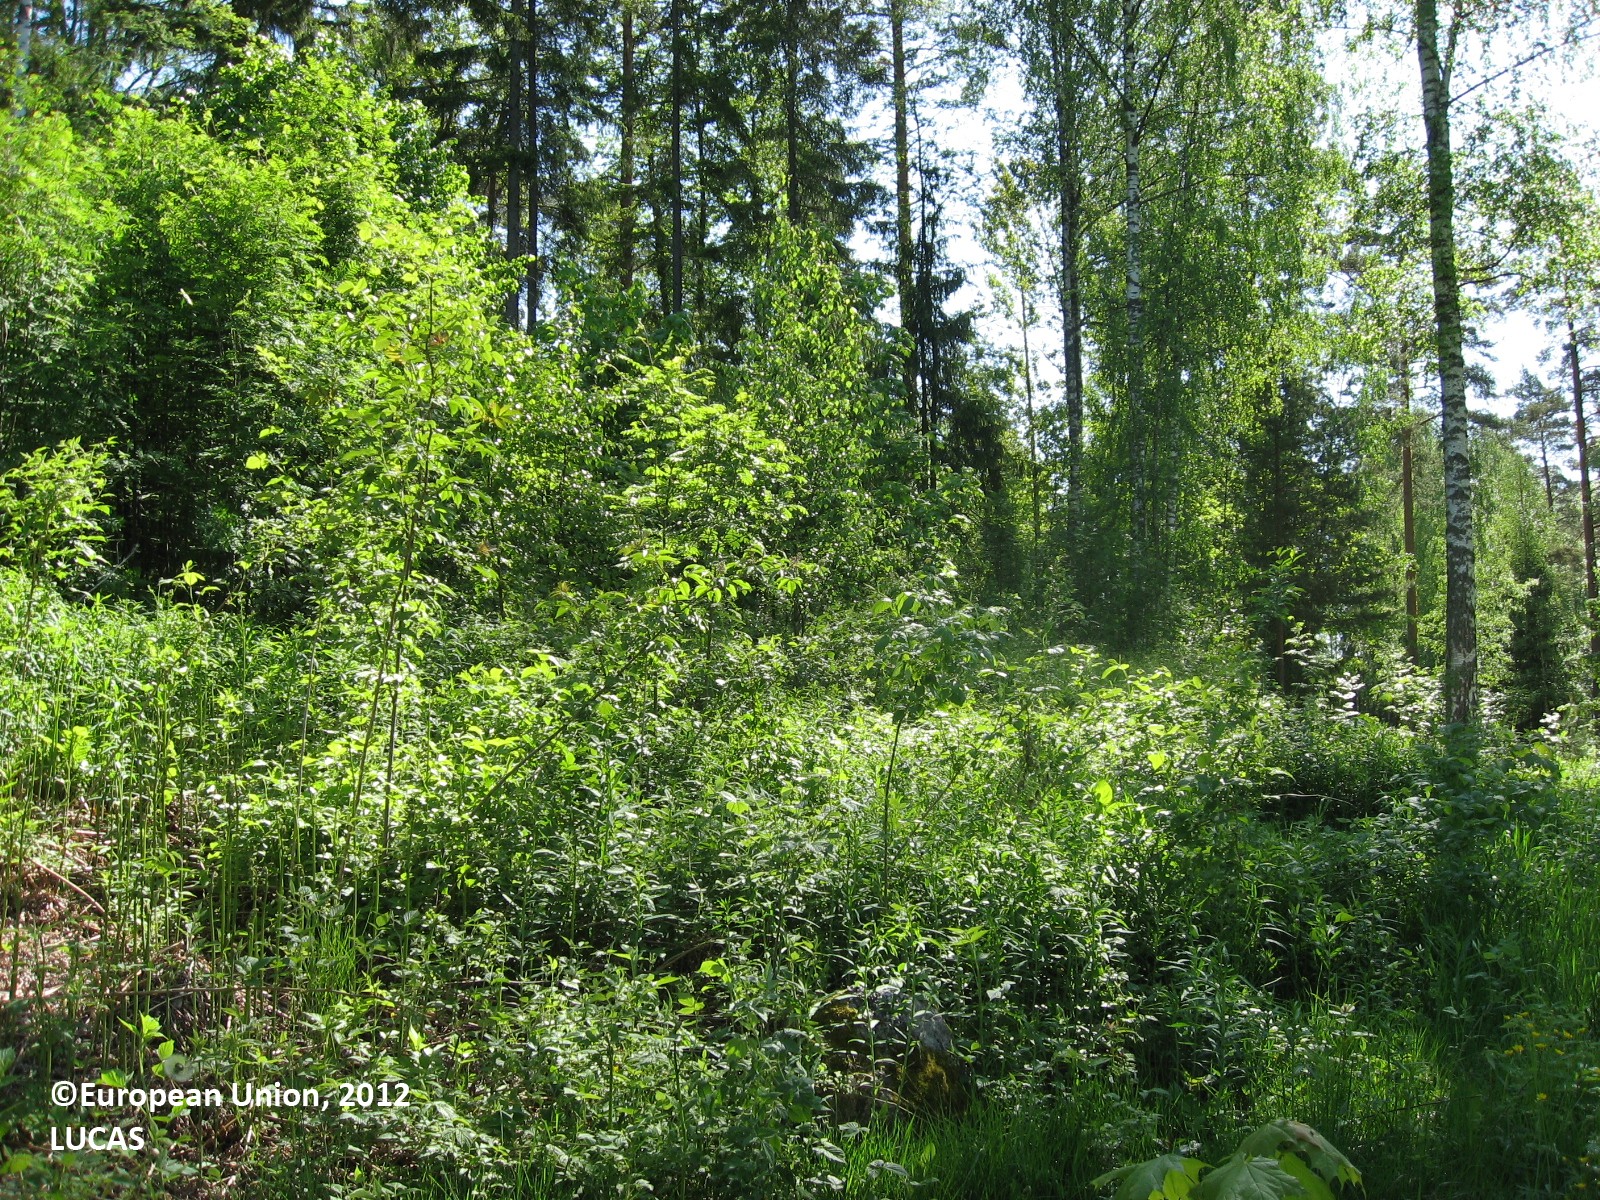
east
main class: Woodland
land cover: Broadleaved woodland
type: boreal forest
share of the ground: > 75 %
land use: Forestry
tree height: > 5 m
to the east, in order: Broadleaved woodland; Shrubland with sparse tree cover; Broadleaved woodland; Pine dominated mixed woodland; Spruce dominated mixed woodland; Broadleaved woodland; Grassland with sparse tree/shrub cover; Broadleaved woodland
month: June
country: FI
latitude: 60.3644
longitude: 25.3374
